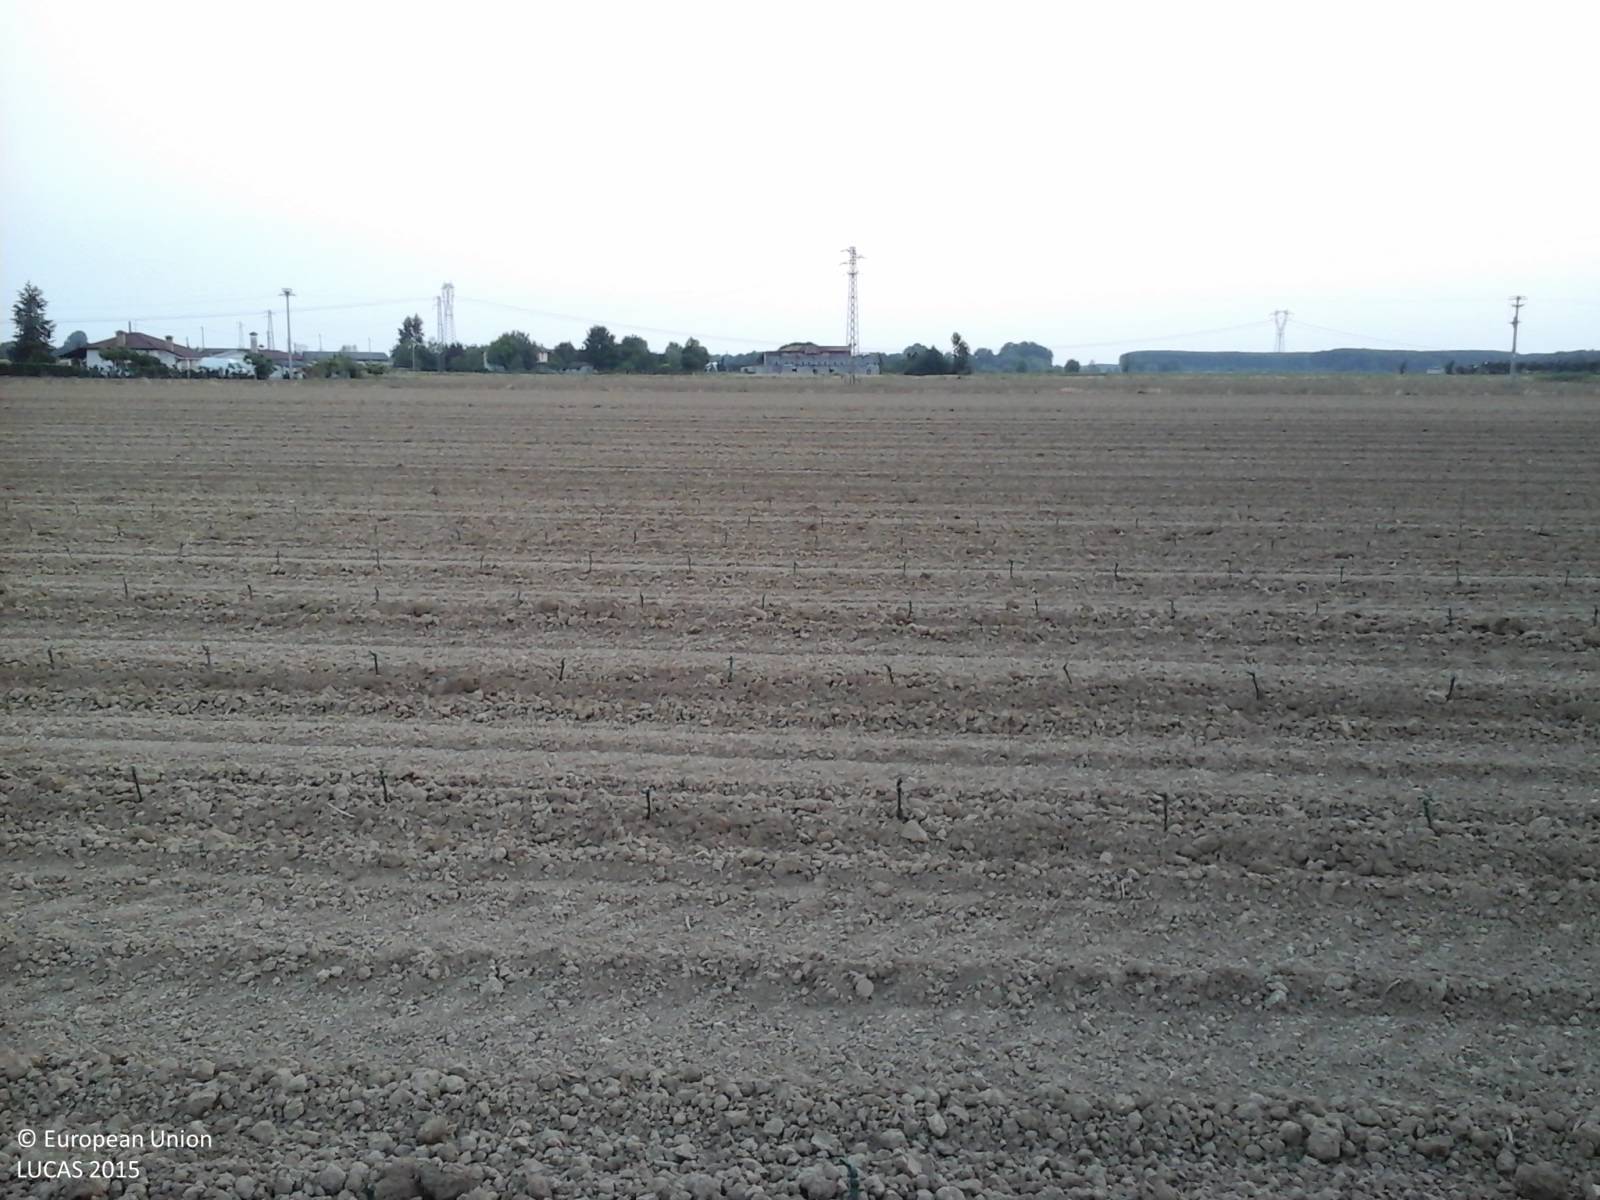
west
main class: Cropland
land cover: Vineyards
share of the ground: < 10 %
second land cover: Other bare soil
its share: > 75 %
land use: Agriculture (excluding fallow land and kitchen gardens)
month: June
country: IT
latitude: 45.8166
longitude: 13.2007
